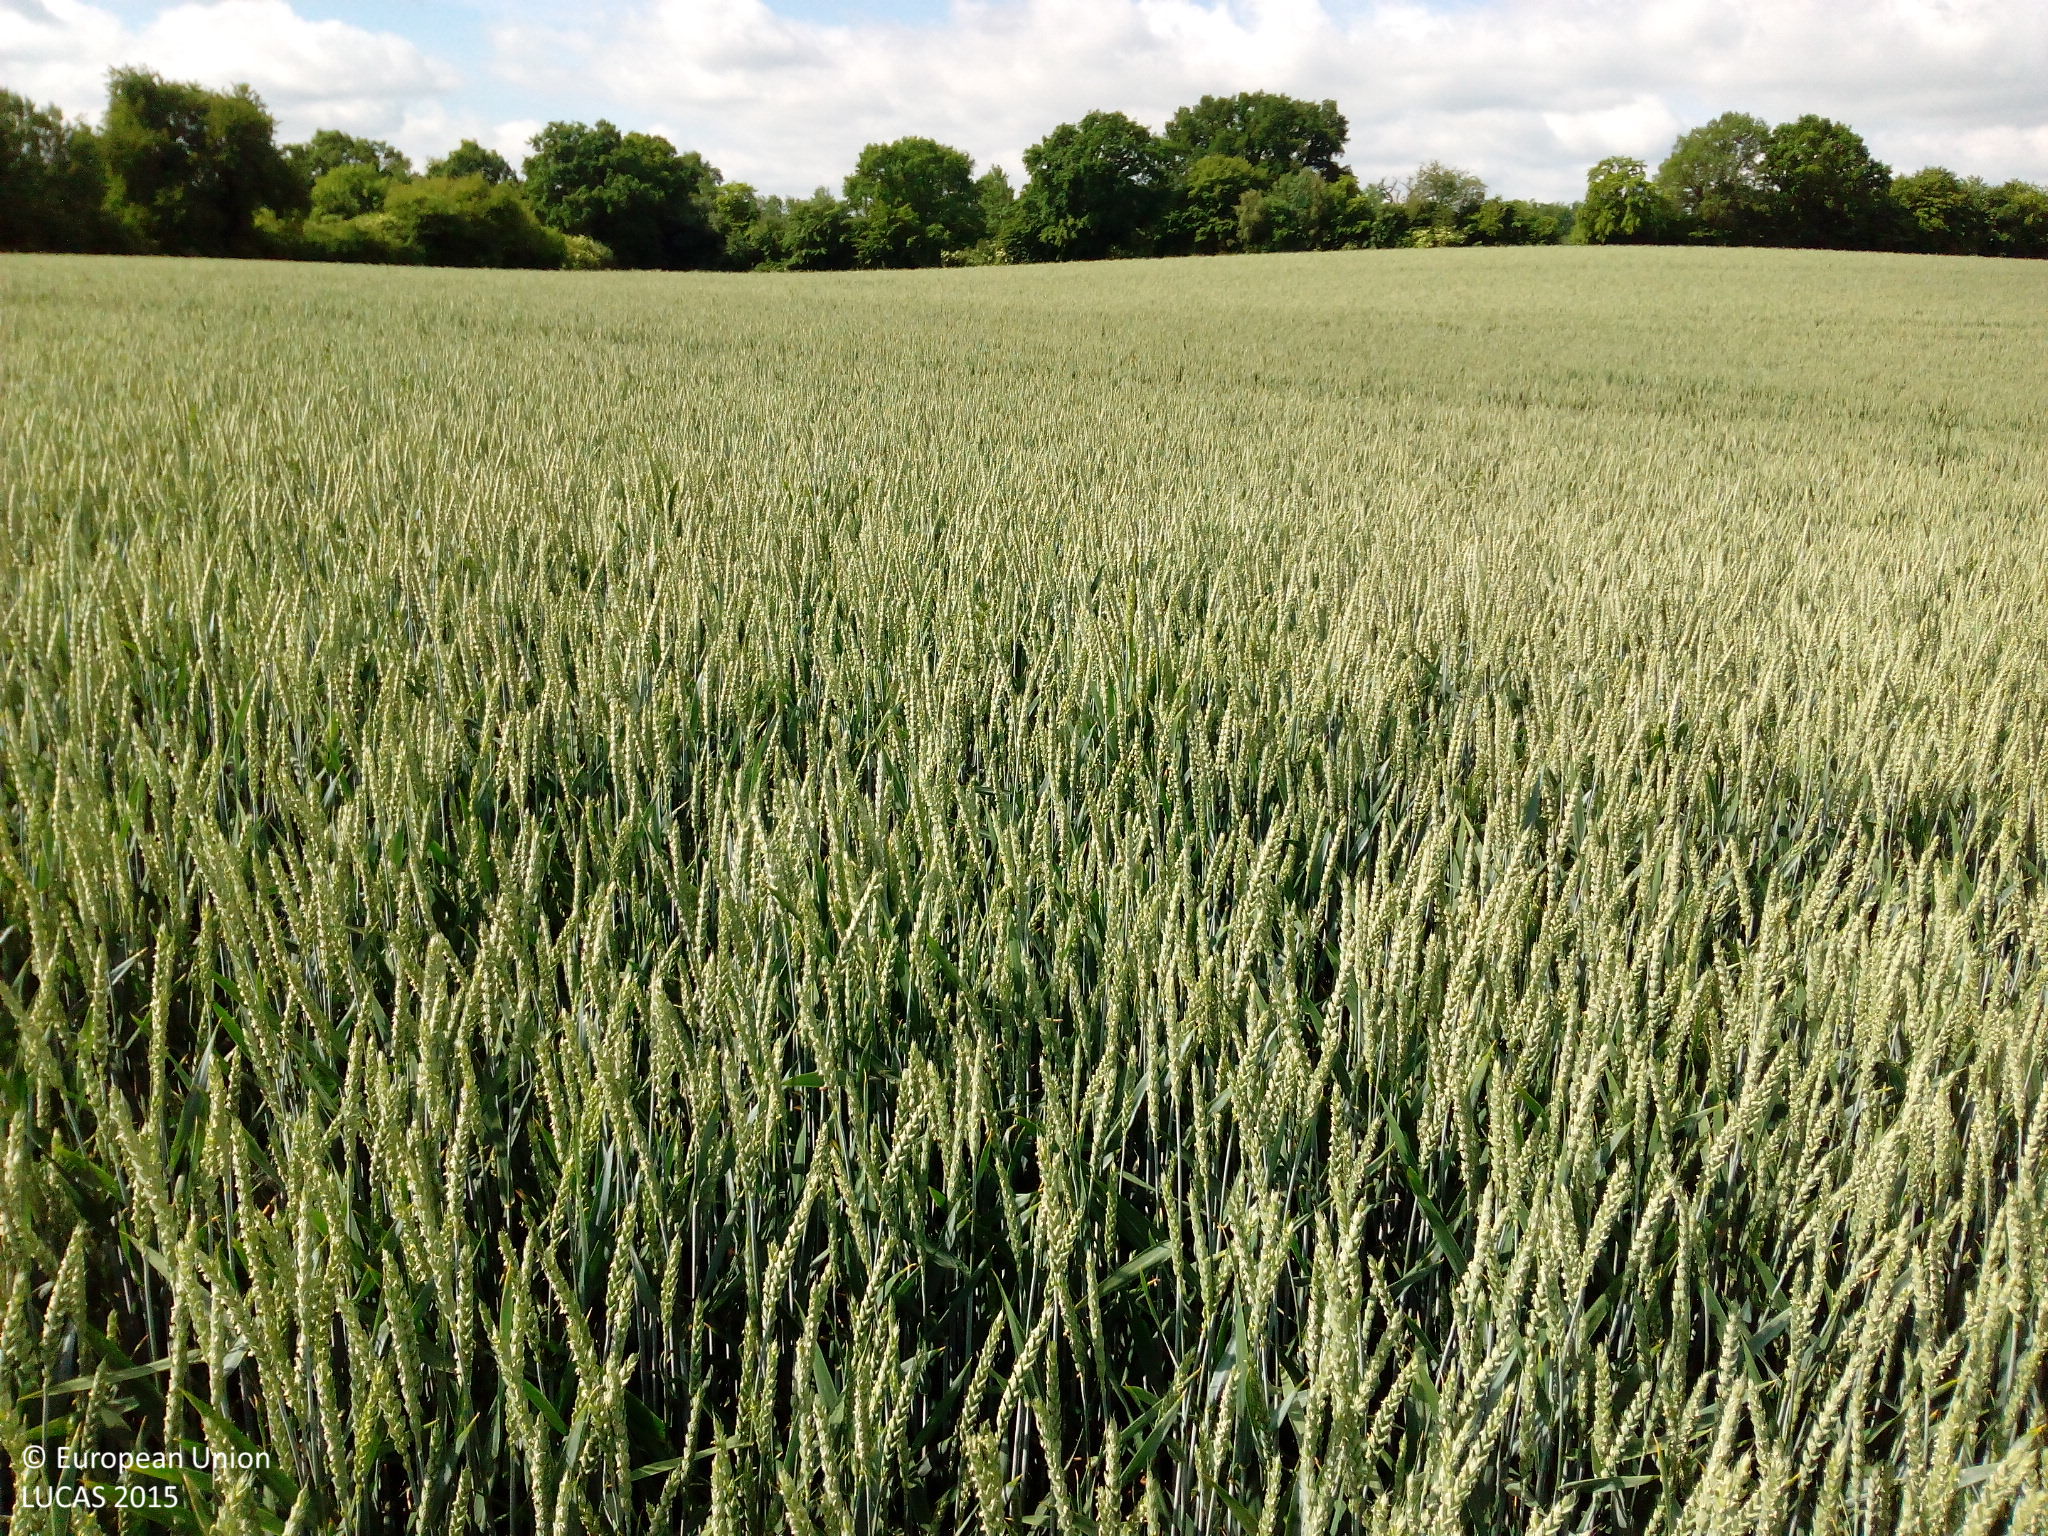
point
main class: Cropland
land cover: Common wheat
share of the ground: > 75 %
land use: Agriculture (excluding fallow land and kitchen gardens)
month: June
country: DE
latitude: 53.7561
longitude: 11.1370
